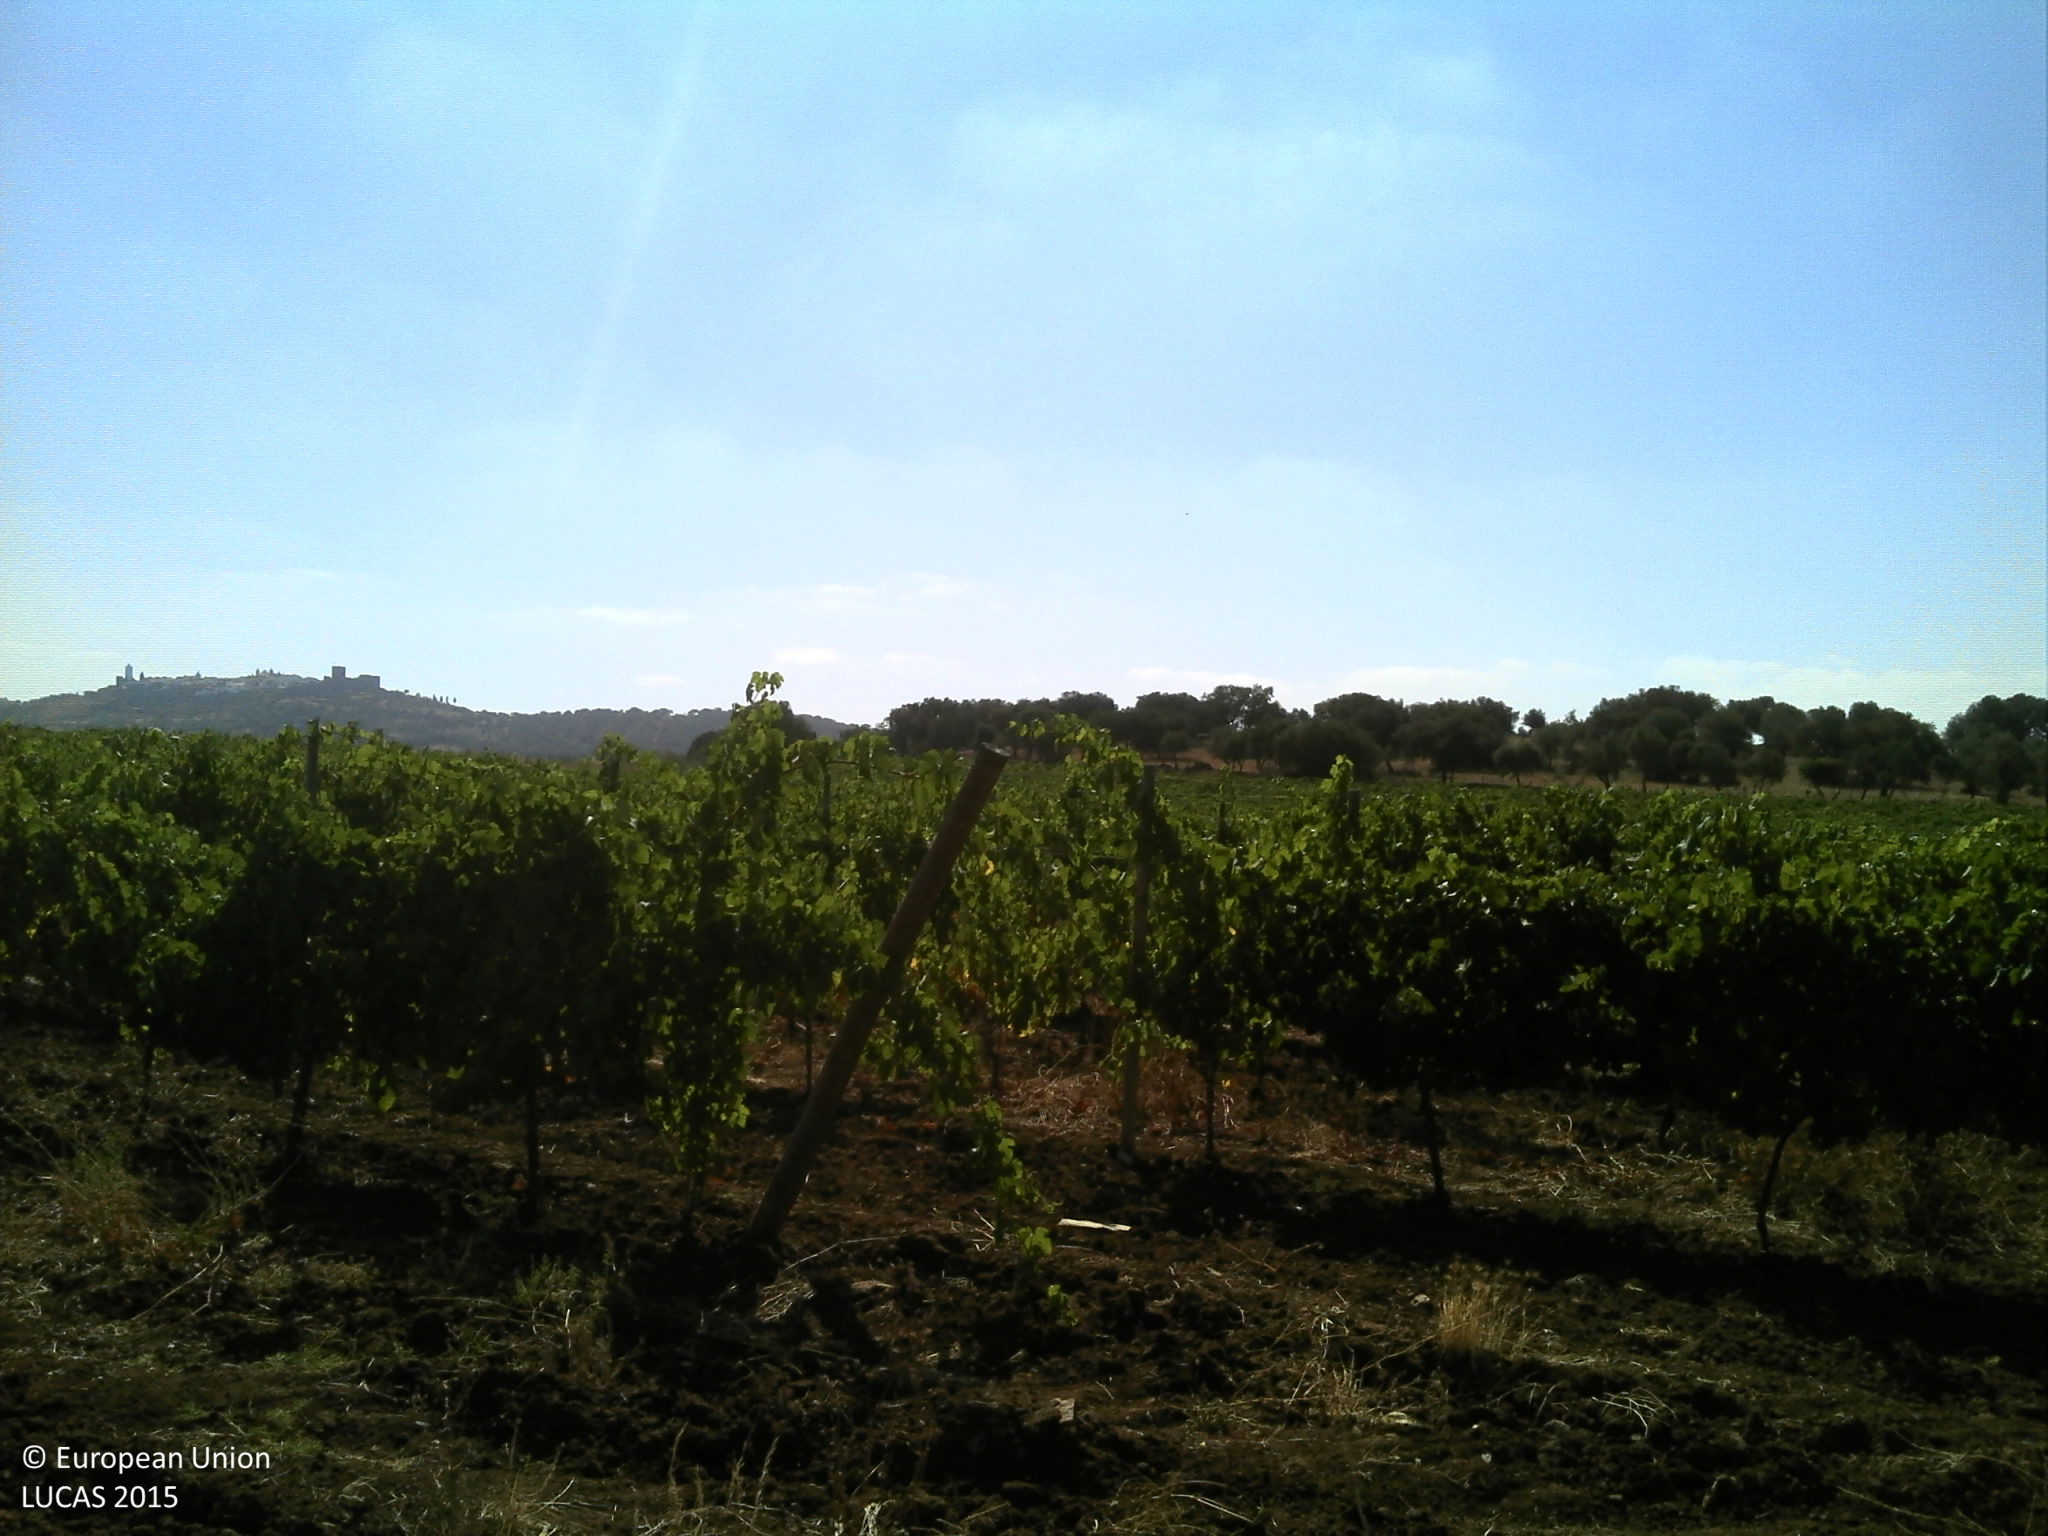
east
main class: Grassland
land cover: Grassland without tree/shrub cover
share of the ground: 50 - 75 %
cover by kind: herbaceous plants 50 %, unconsolidated bare surface 50 %
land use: Agriculture (excluding fallow land and kitchen gardens)
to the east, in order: Grassland without tree/shrub cover; Vineyards; Grass margins; Tracks; Grass margins; Fences; Mixed cereals for fodder
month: July
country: PT
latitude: 38.4395
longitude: -7.4052
